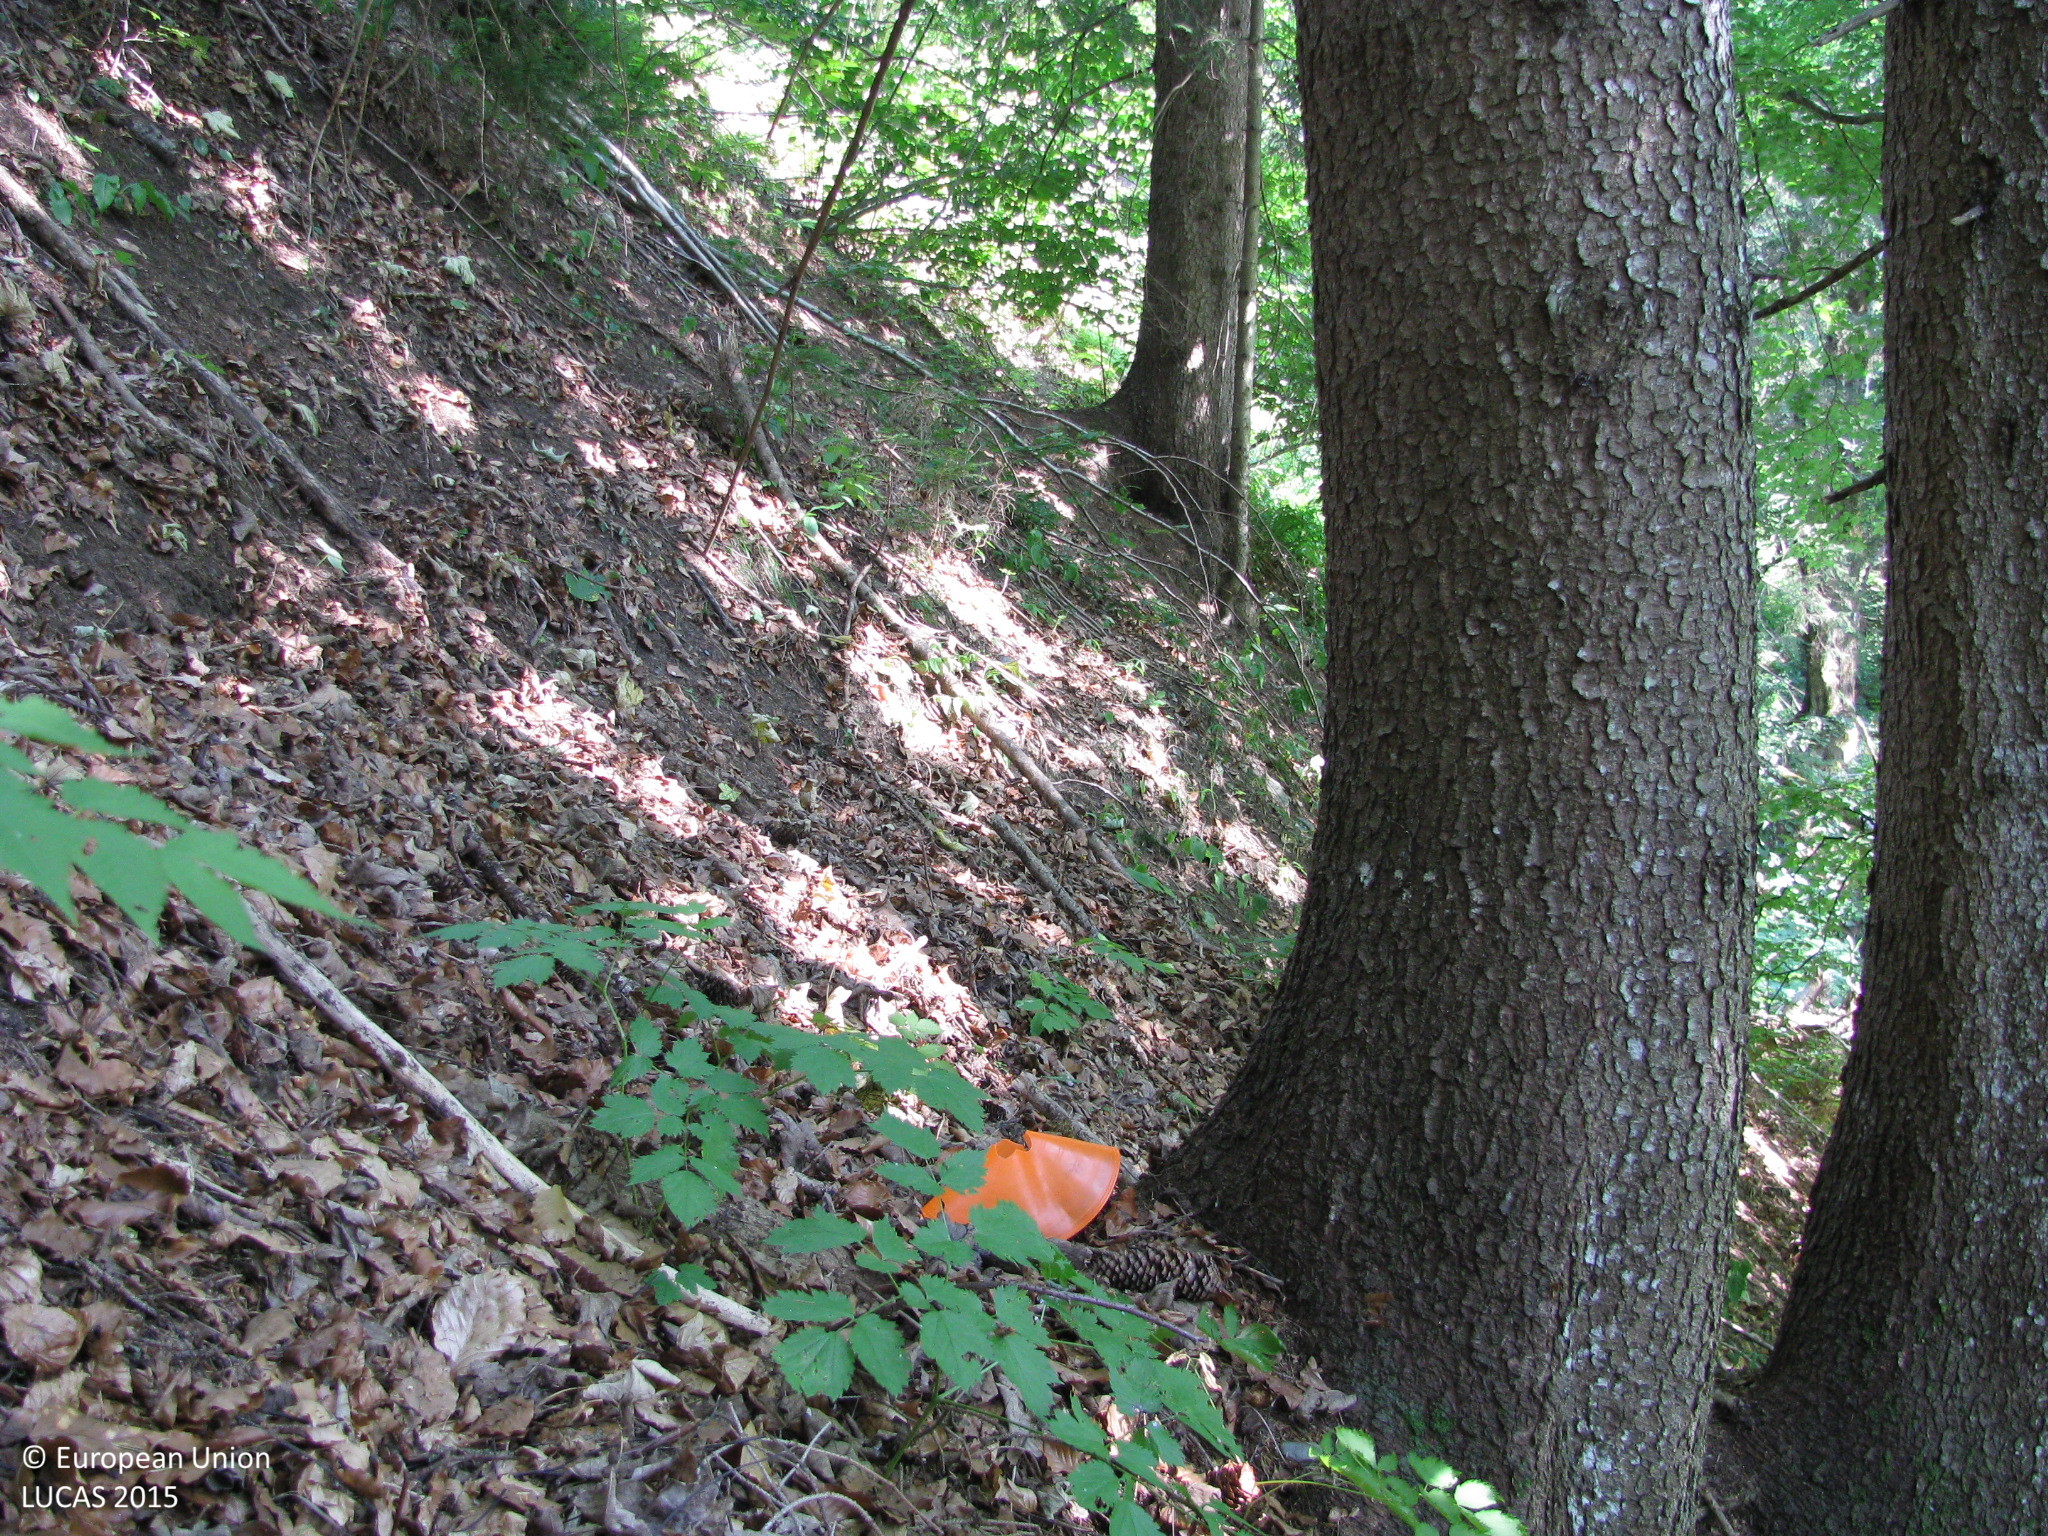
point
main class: Woodland
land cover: Spruce dominated mixed woodland
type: alpine coniferous forest
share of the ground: > 75 %
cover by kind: coniferous forest trees 50 %, broadleaved forest trees 35 %, unconsolidated bare surface 10 %, herbaceous plants 5 %
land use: Forestry
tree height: > 5 m
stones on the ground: < 10 %
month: July
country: AT
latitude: 46.6928
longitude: 12.8088
